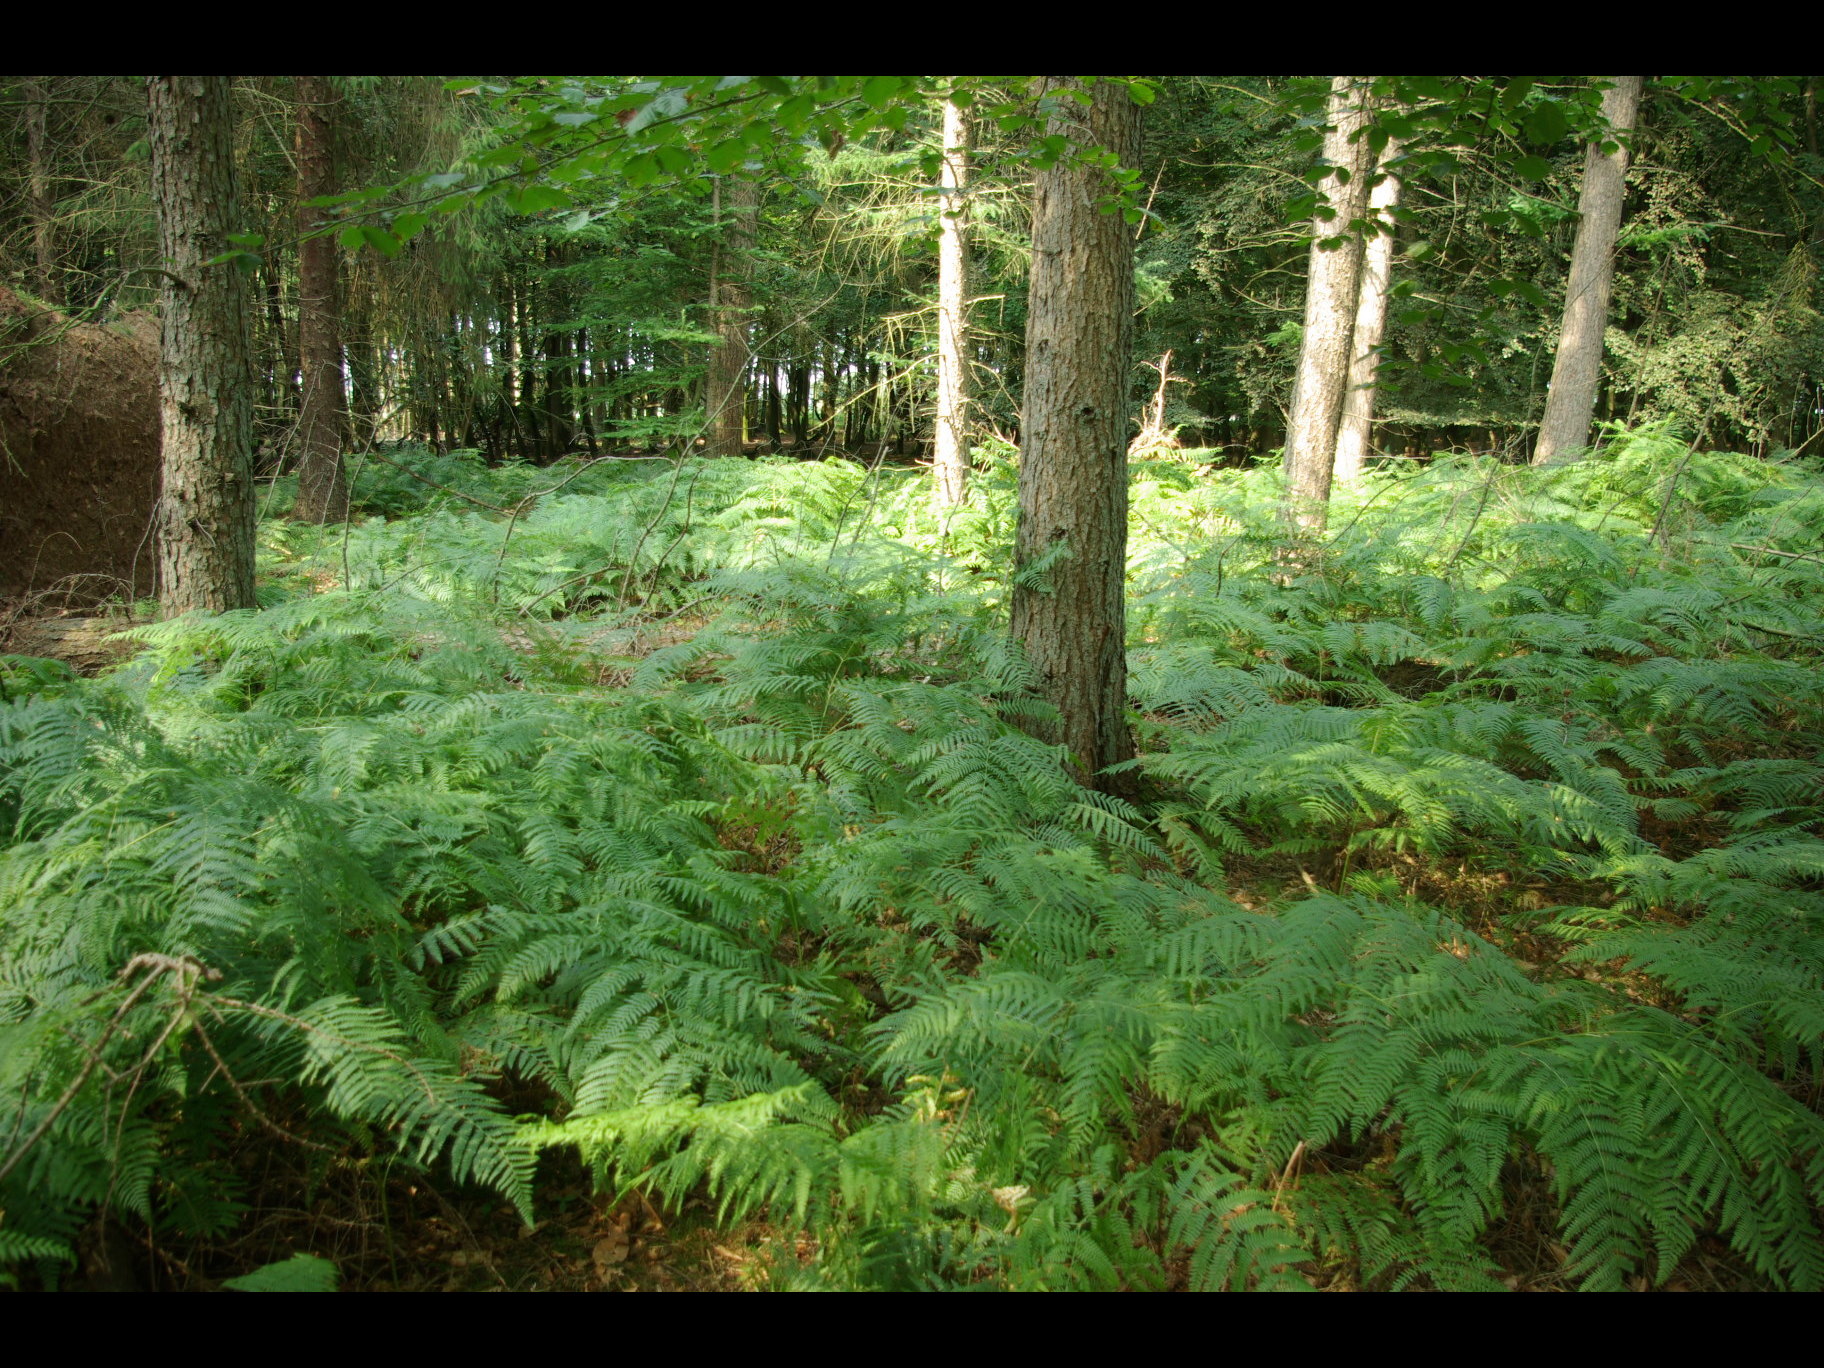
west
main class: Woodland
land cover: Other coniferous woodland
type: hemiboreal forest and nemoral coniferous forest and mixed broadleaved-coniferous forest
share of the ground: 50 - 75 %
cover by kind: coniferous forest trees 70 %, herbaceous plants 15 %, unconsolidated bare surface 10 %, broadleaved forest trees 5 %
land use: Forestry
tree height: > 5 m
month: August
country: DE
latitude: 54.6037
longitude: 9.2420
